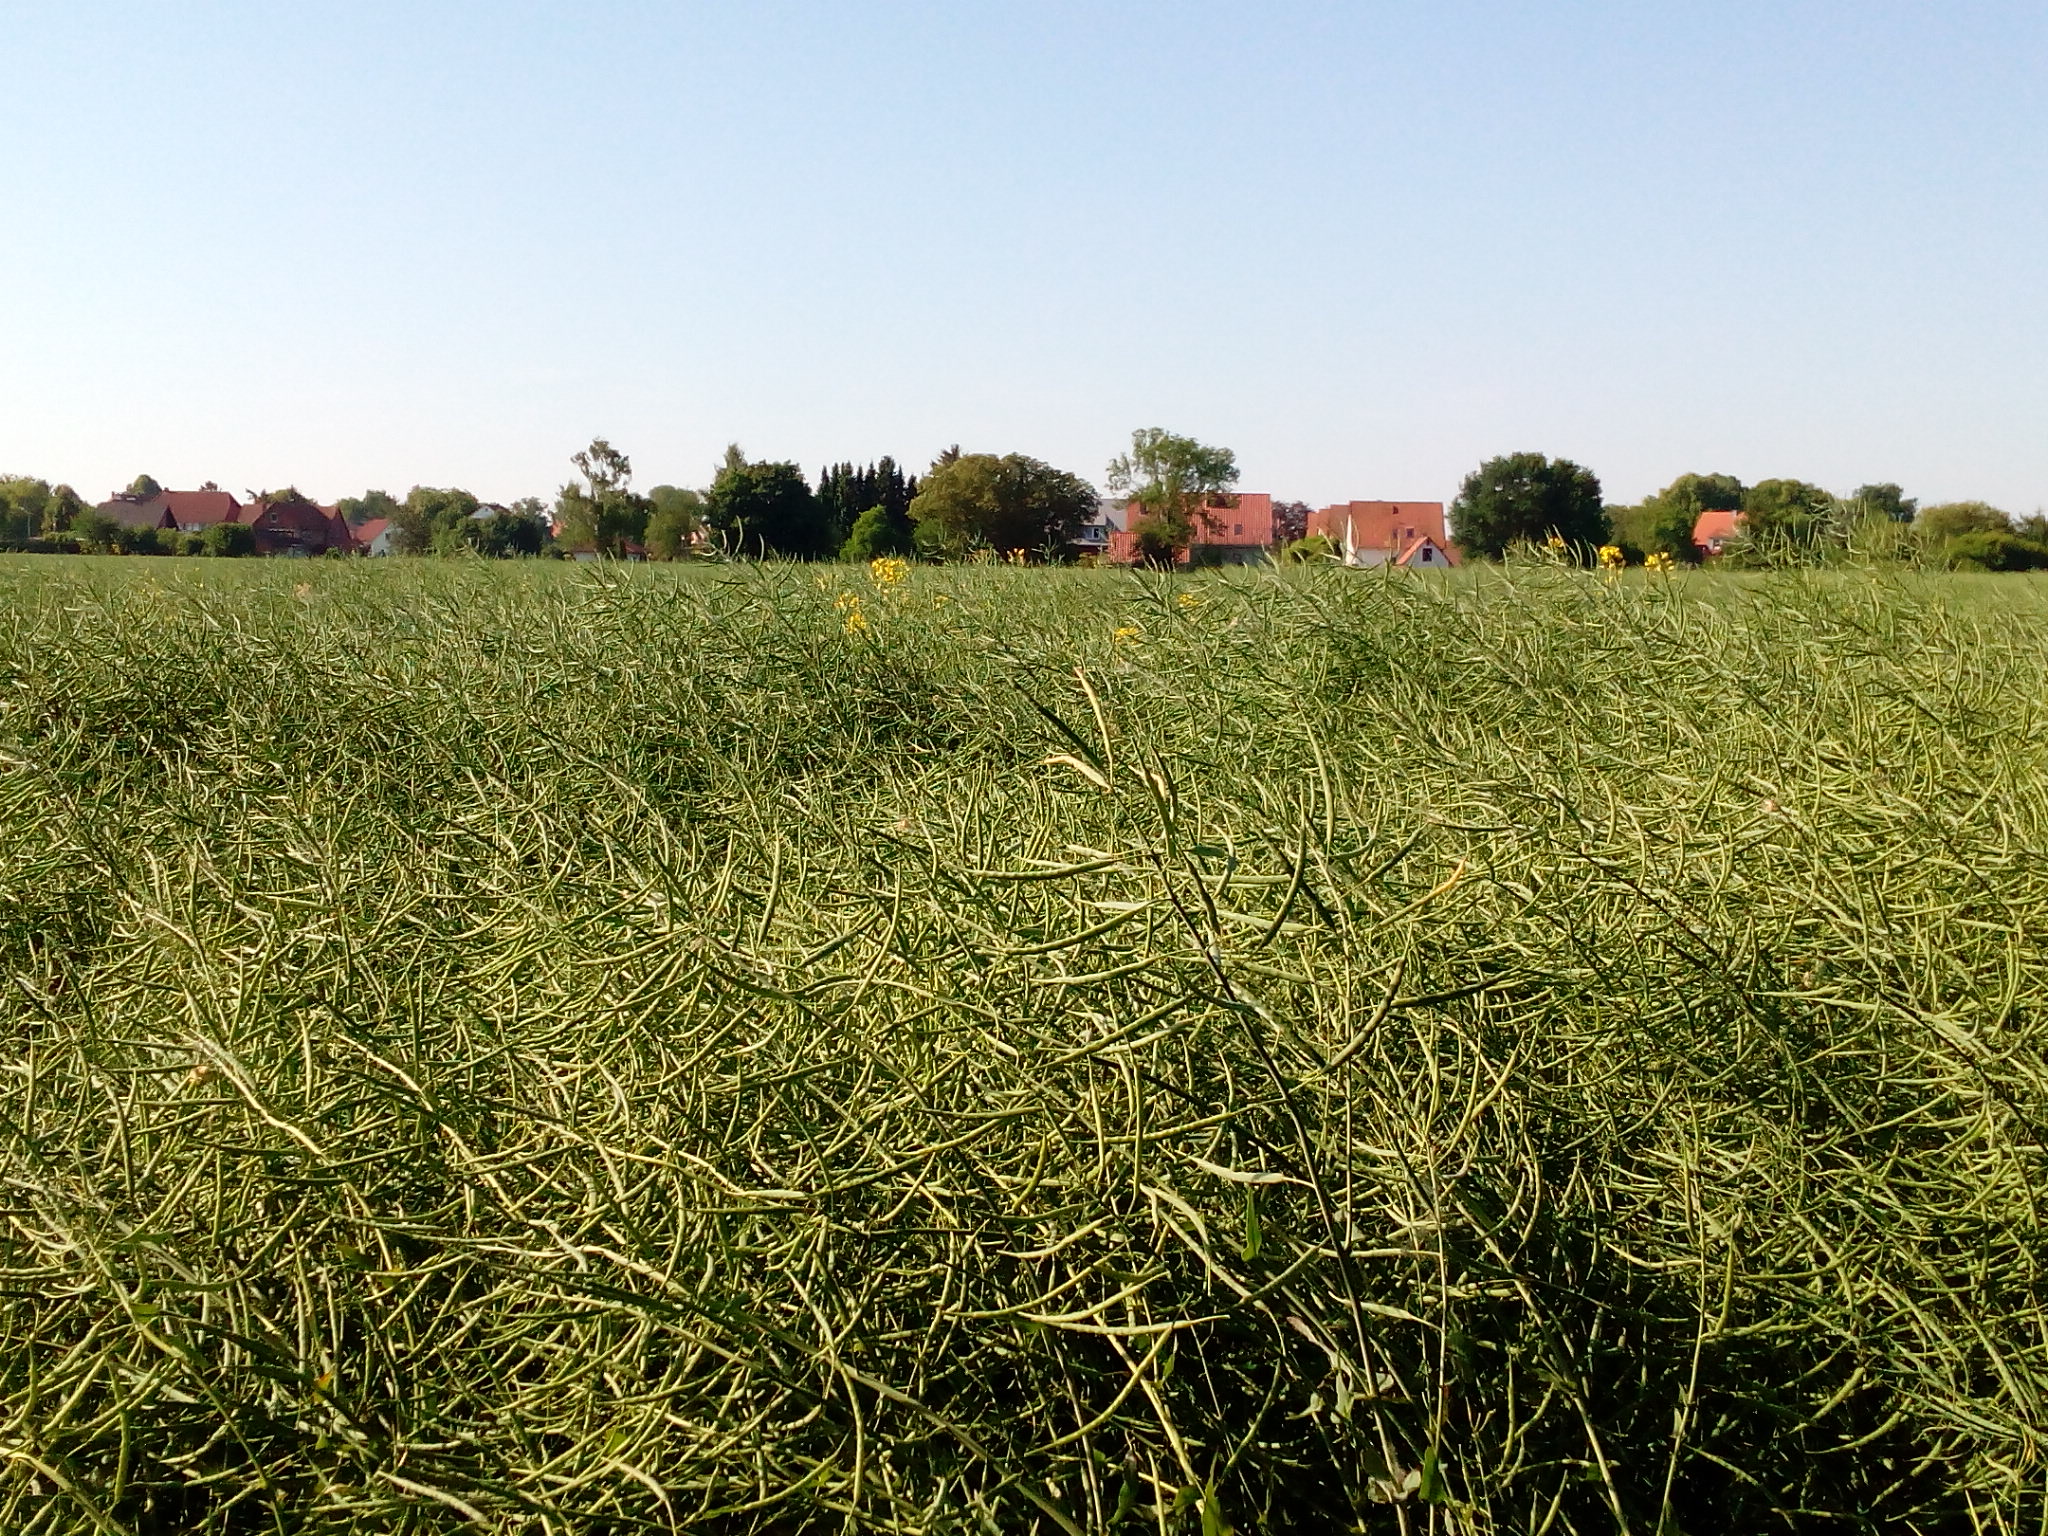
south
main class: Cropland
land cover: Rape and turnip rape
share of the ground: > 75 %
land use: Agriculture (excluding fallow land and kitchen gardens)
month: June
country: DE
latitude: 52.3235
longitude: 9.9267
